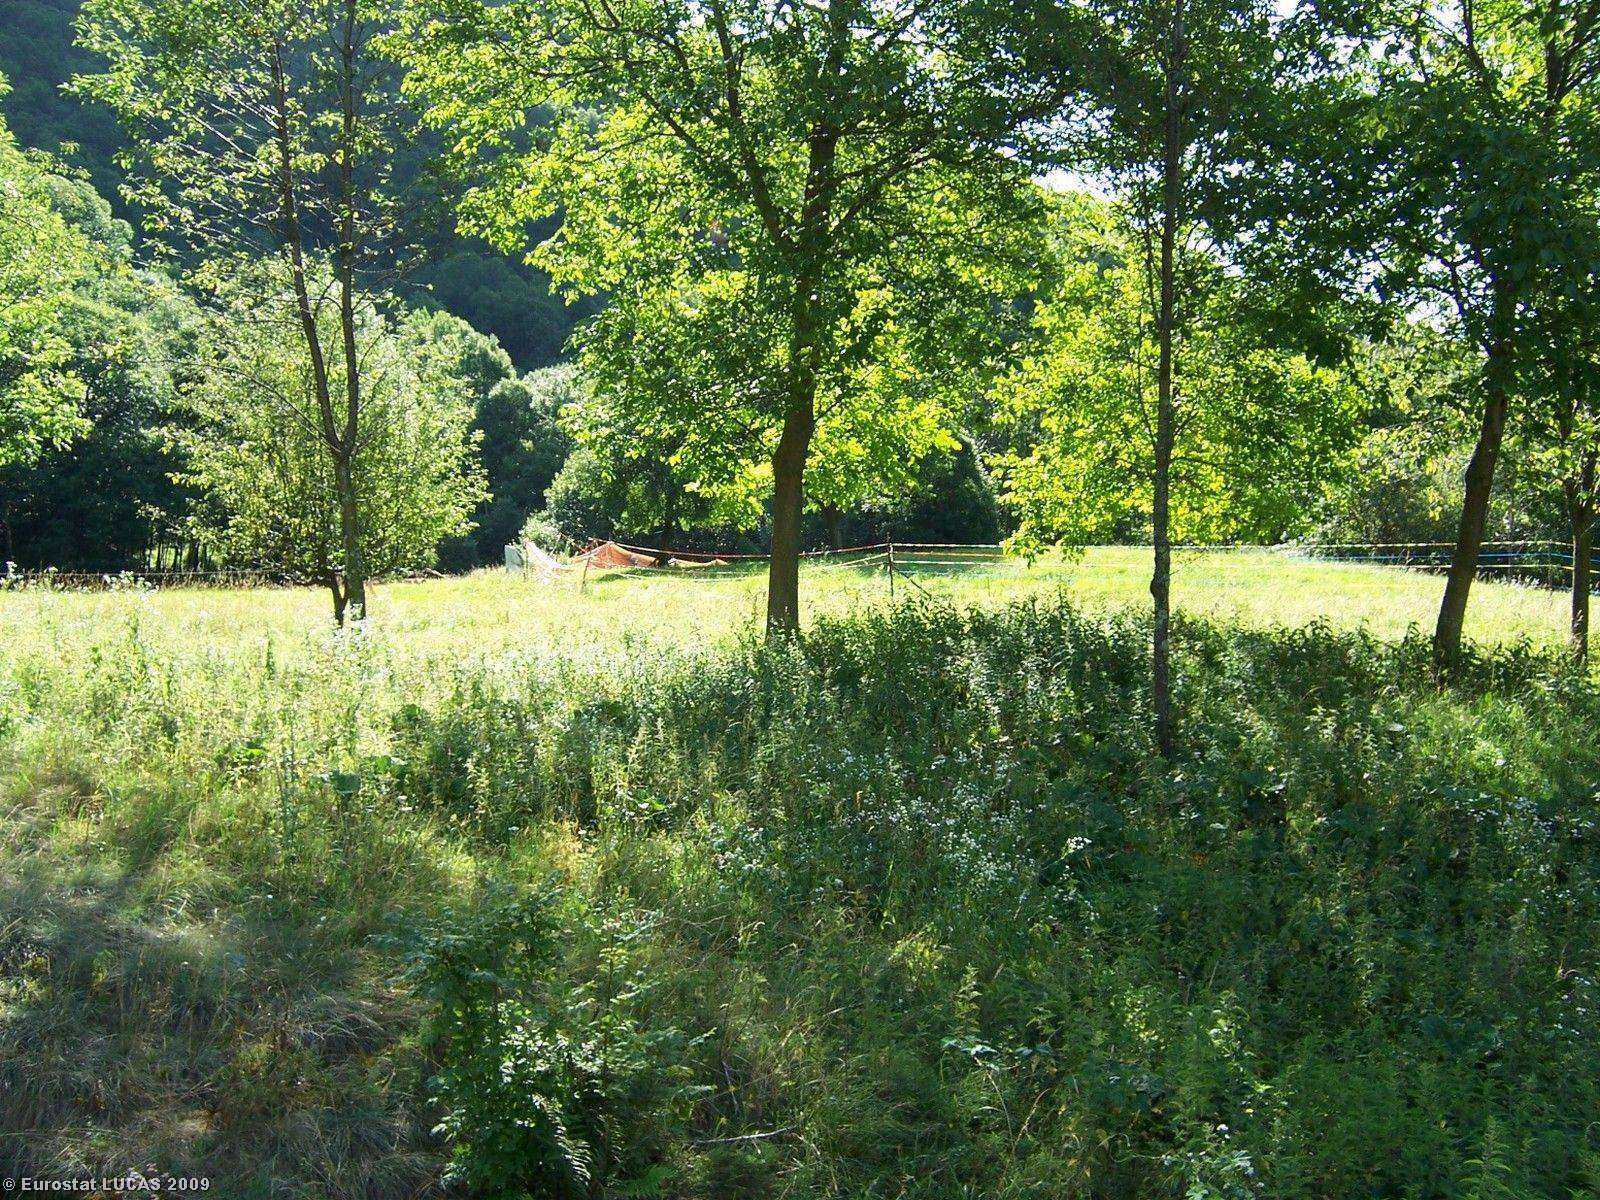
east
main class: Woodland
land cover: Broadleaved woodland
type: mesophytic deciduous forest
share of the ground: > 75 %
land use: Unused
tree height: > 5 m
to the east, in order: Broadleaved woodland
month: July
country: IT
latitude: 45.3272
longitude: 7.3631
